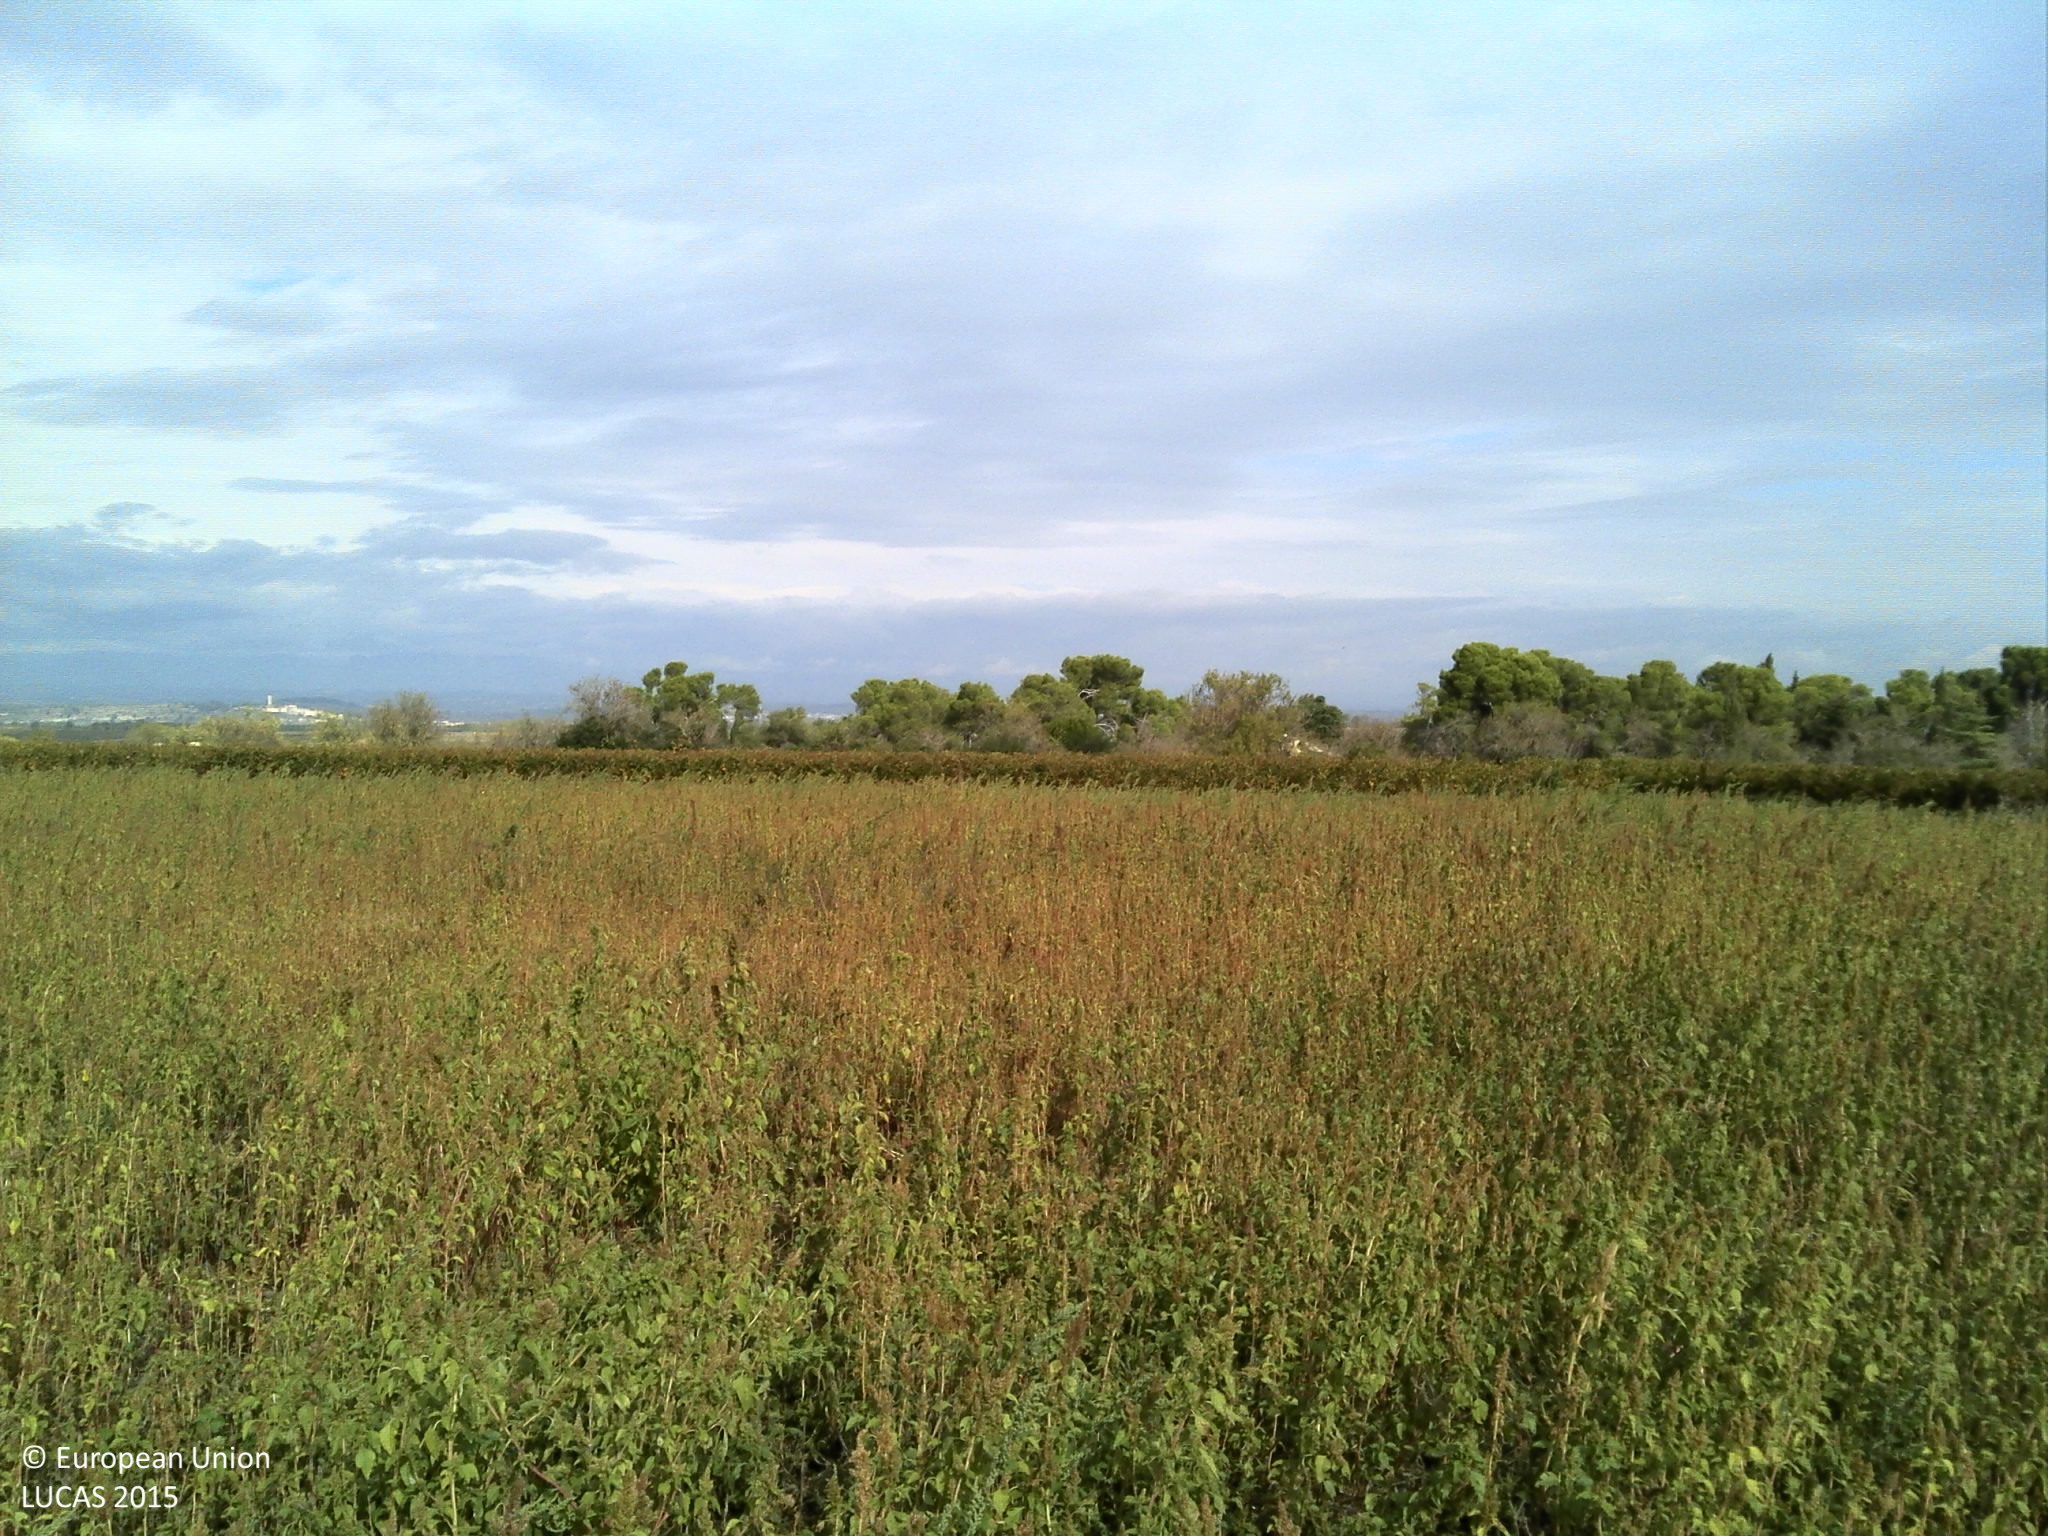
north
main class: Grassland
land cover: Spontaneously vegetated surfaces
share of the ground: > 75 %
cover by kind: herbaceous plants 100 %
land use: Abandoned areas
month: October
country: FR
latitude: 43.2910
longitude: 3.1445
